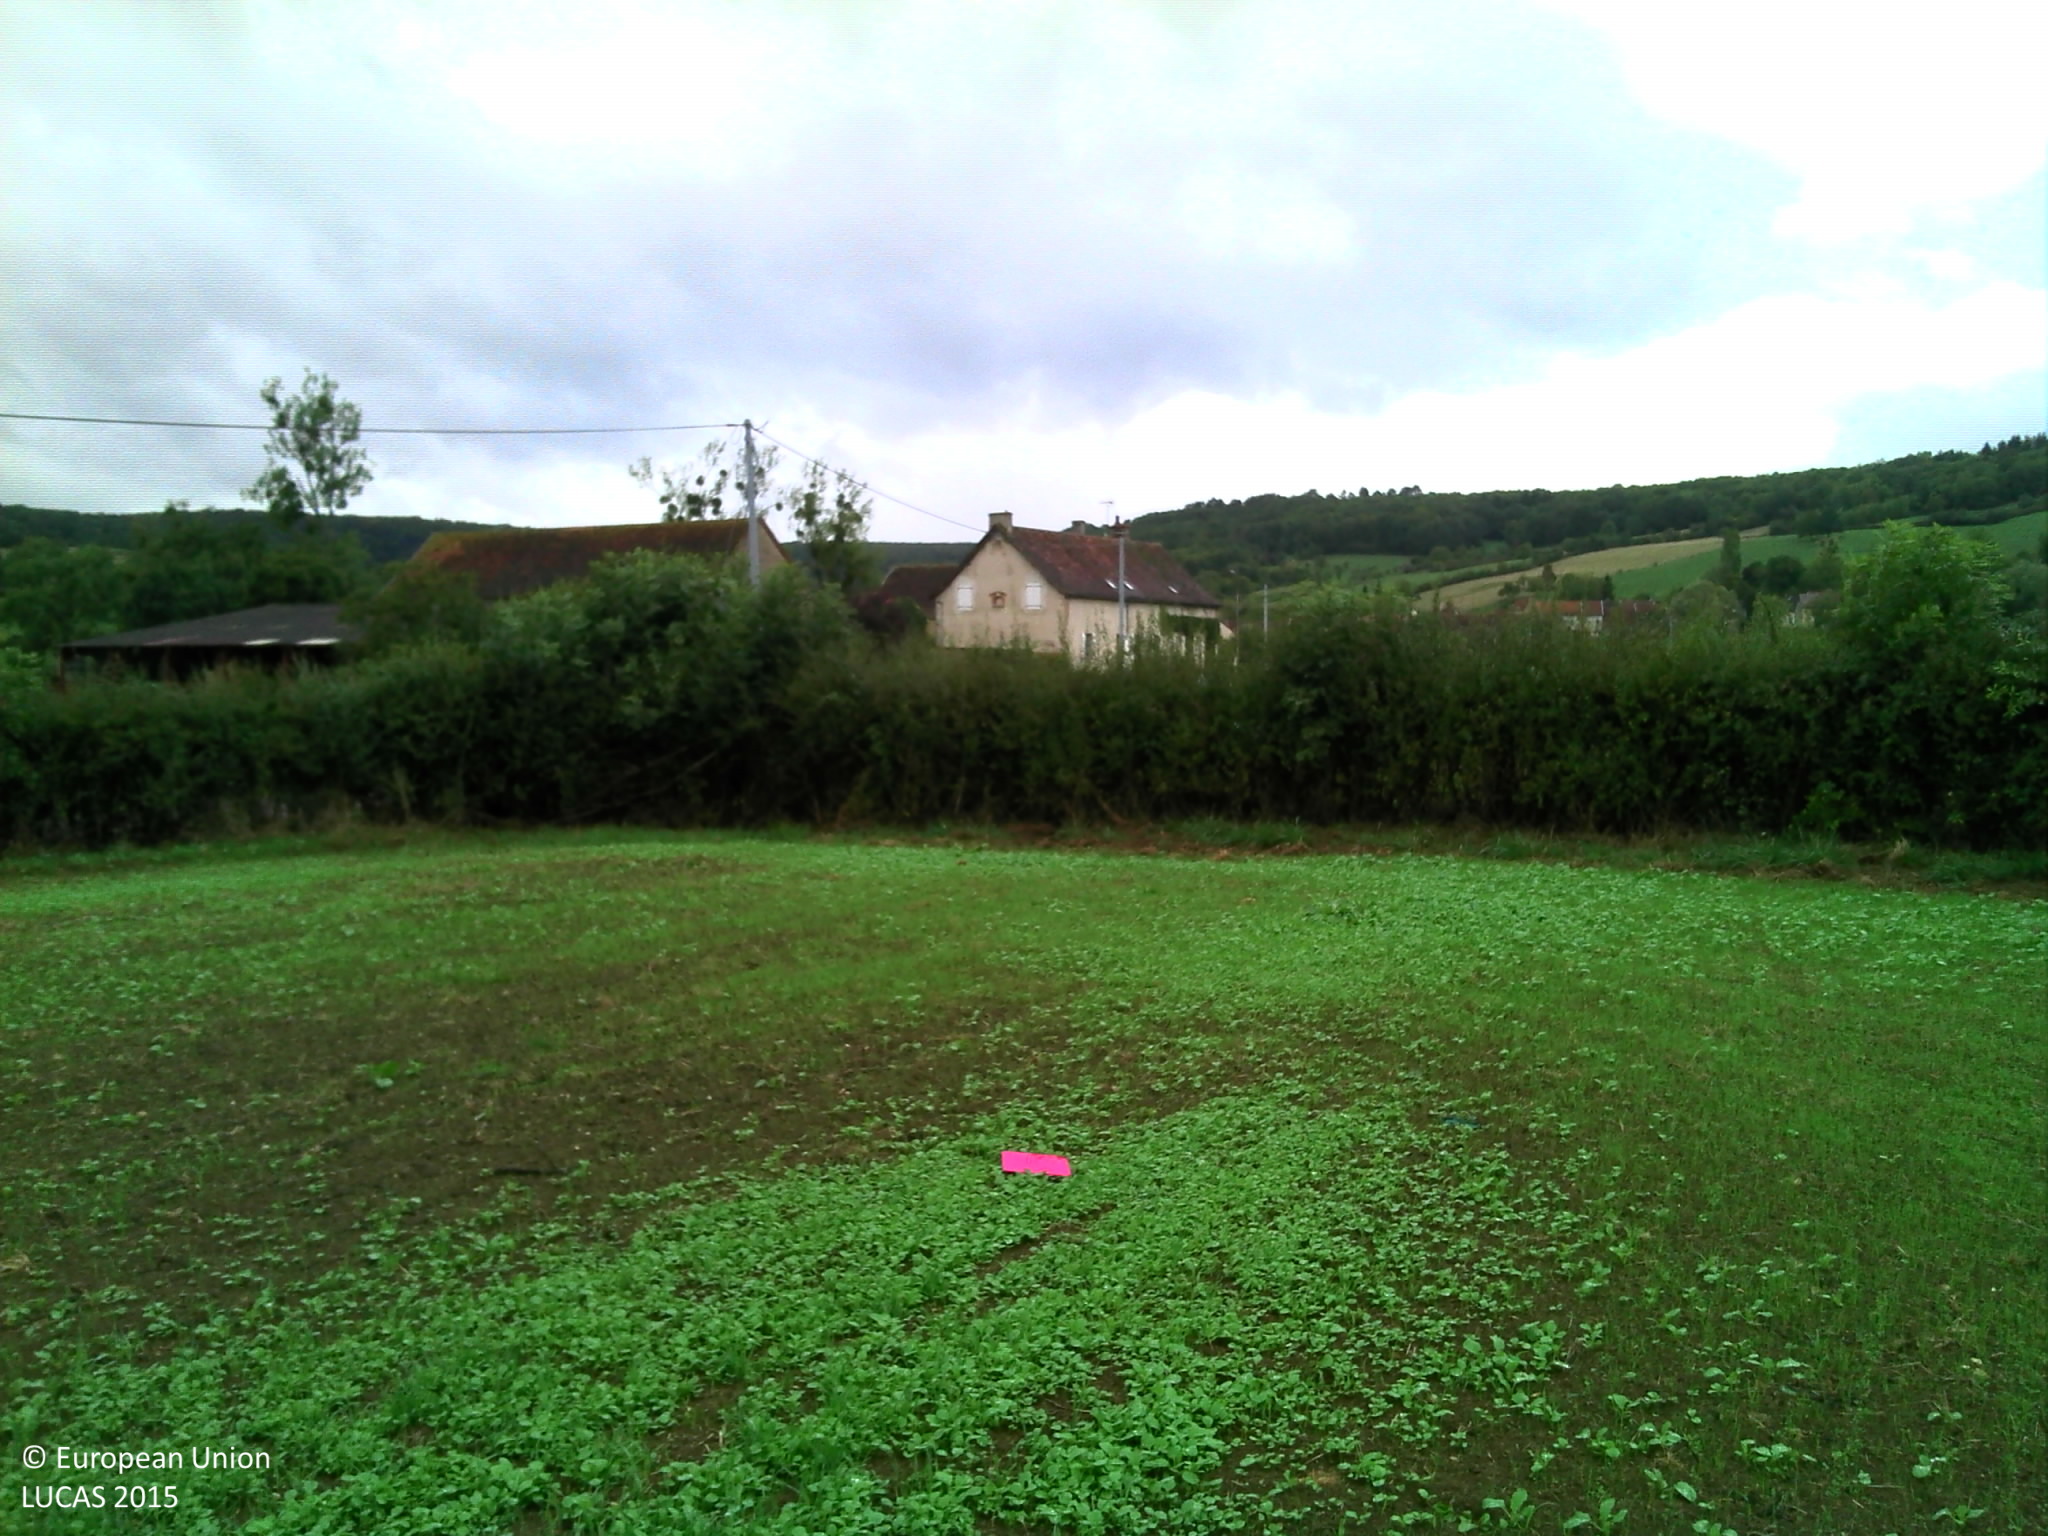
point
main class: Cropland
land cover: Rape and turnip rape
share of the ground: 25 - 50 %
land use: Agriculture (excluding fallow land and kitchen gardens)
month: September
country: FR
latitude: 47.3264
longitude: 4.4552
